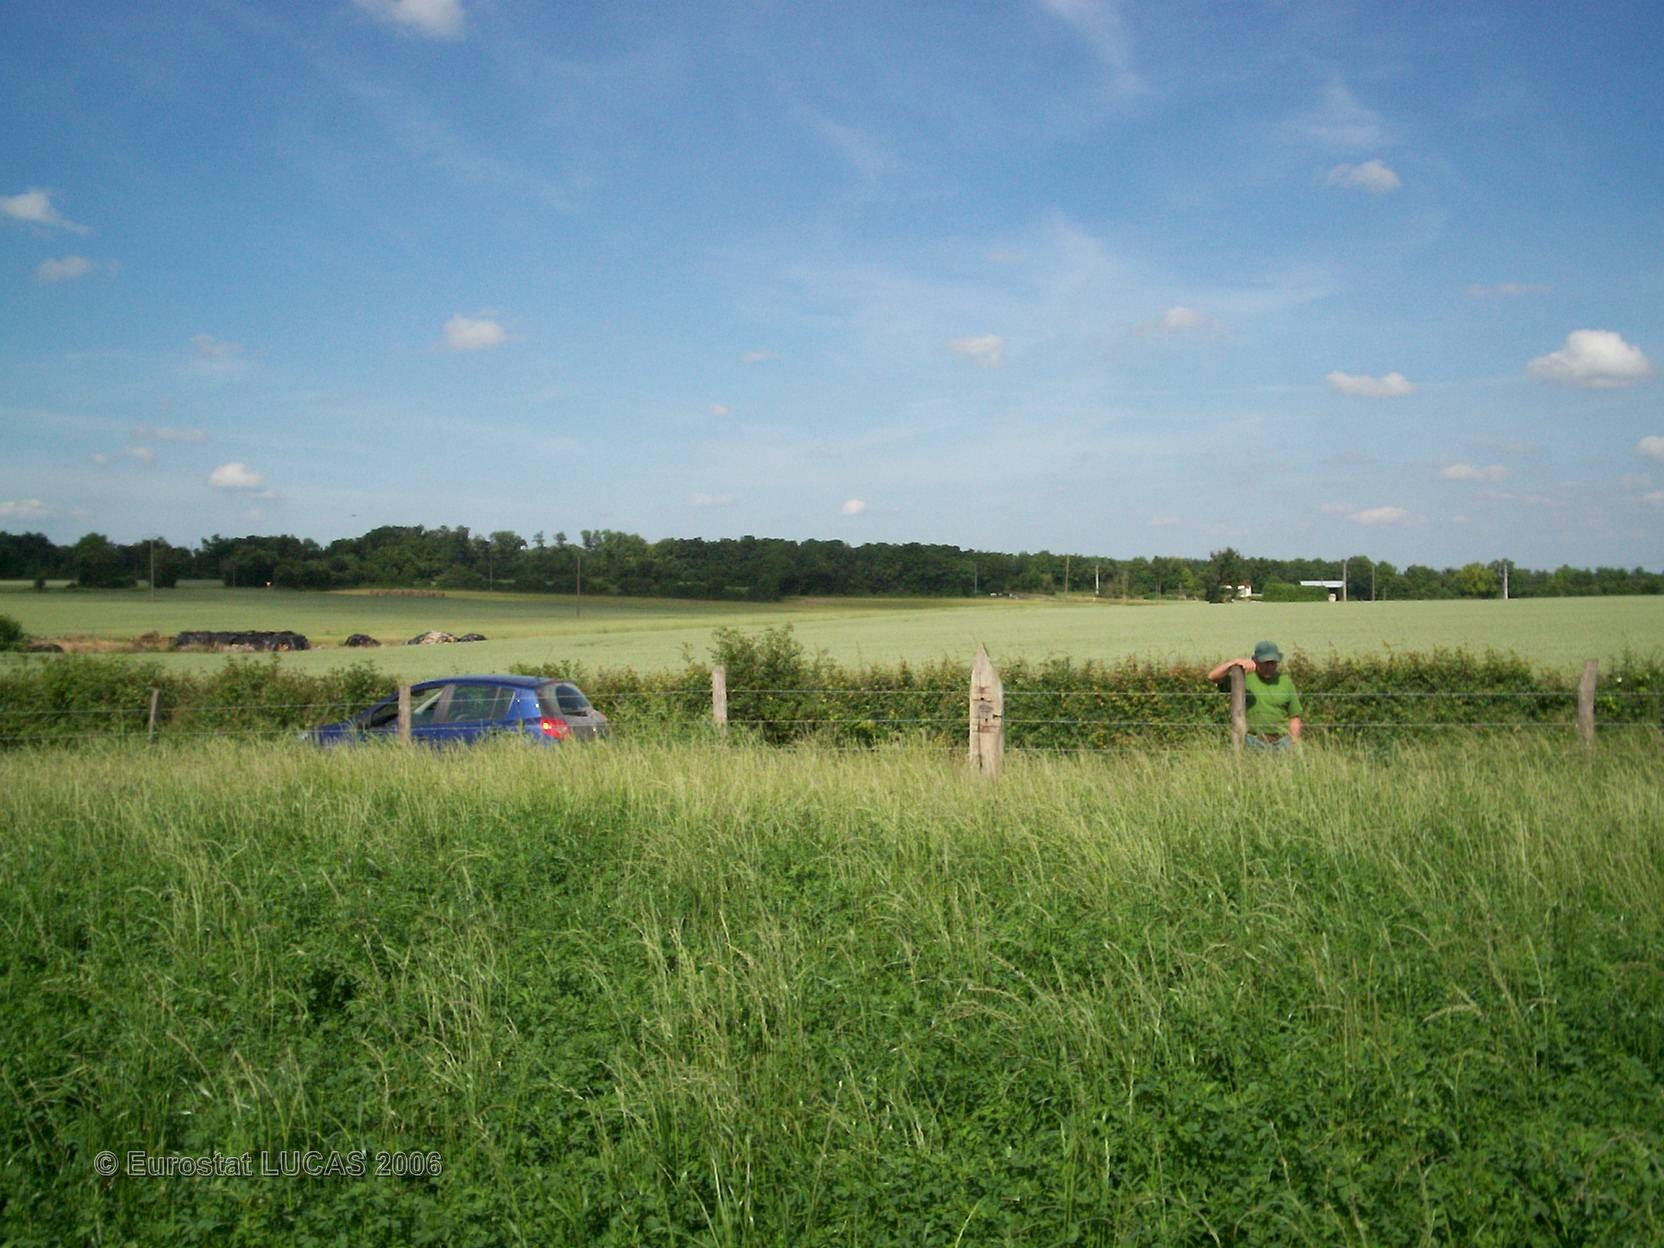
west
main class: Cropland
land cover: Lucerne
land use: Agriculture (excluding fallow land and kitchen gardens)
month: June
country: FR
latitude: 46.0806
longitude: -0.7470
